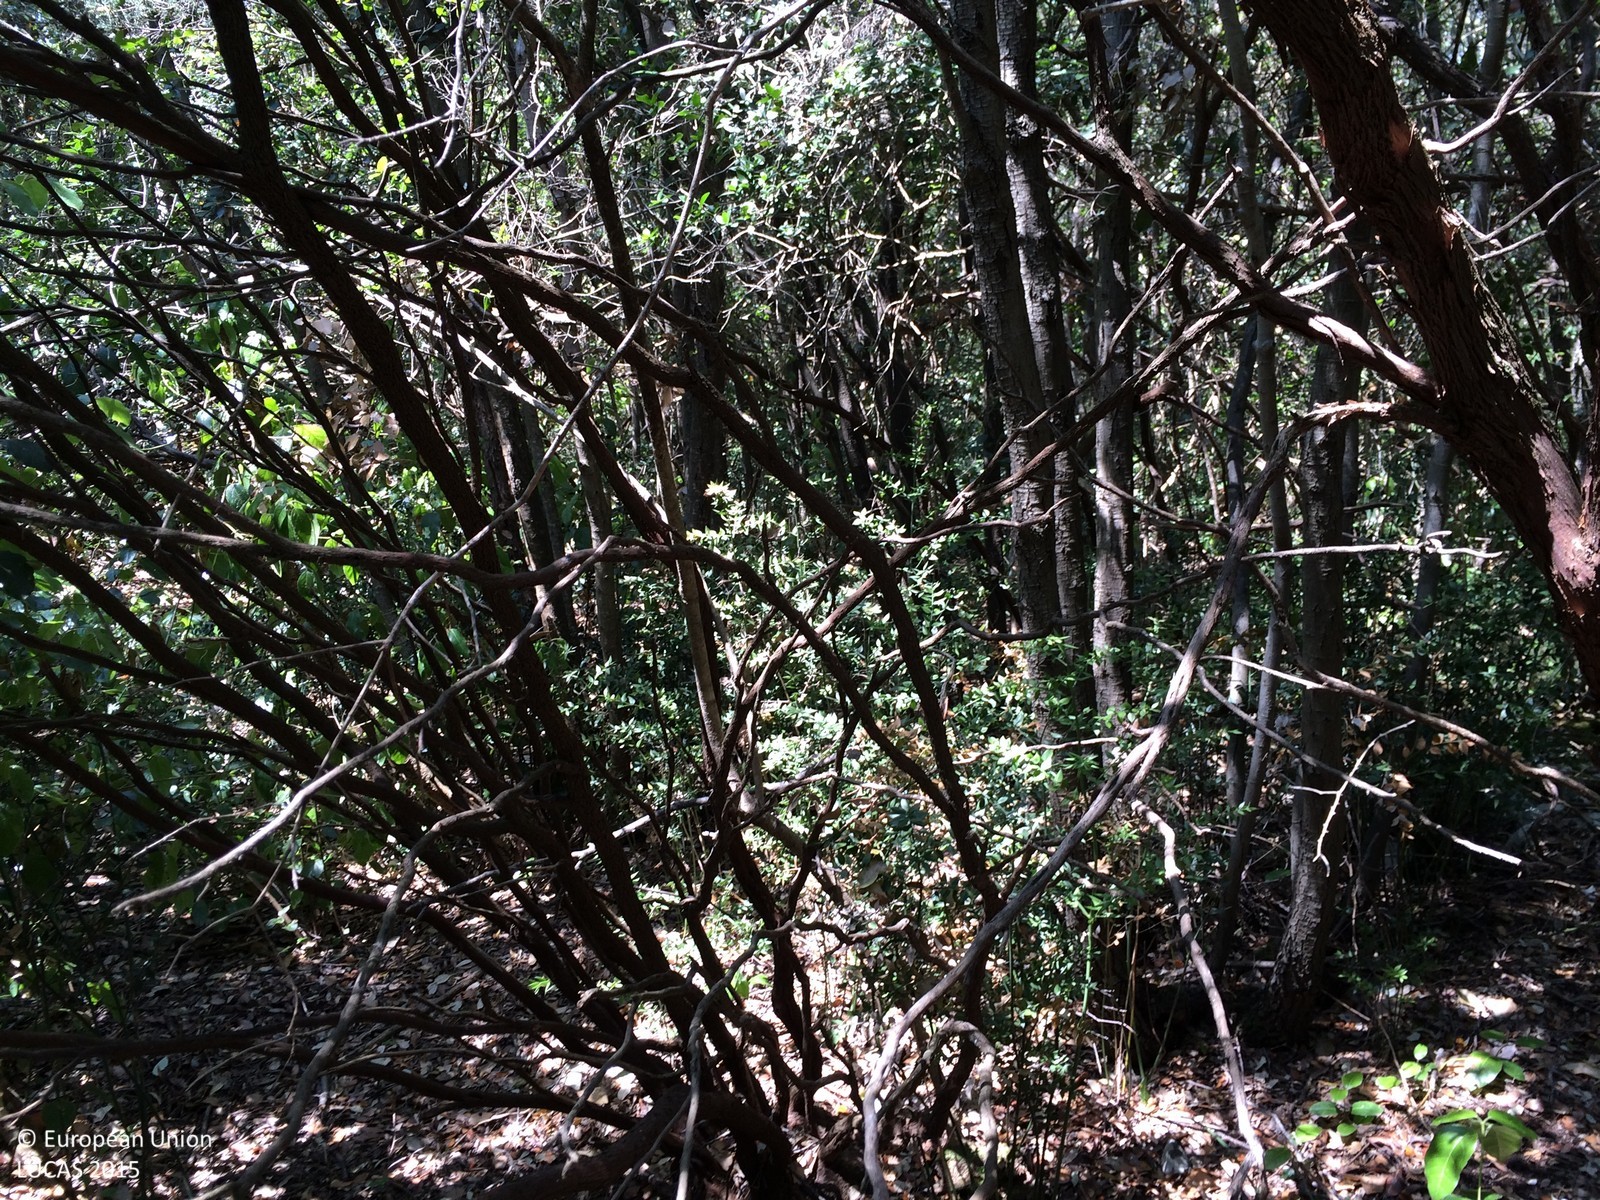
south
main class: Woodland
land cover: Broadleaved woodland
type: broadleaved evergreen forest
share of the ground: > 75 %
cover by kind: broadleaved forest trees 95 %, shrubs 5 %
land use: Semi-natural and natural areas not in use
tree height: > 5 m
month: June
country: HR
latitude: 44.9580
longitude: 14.0380
